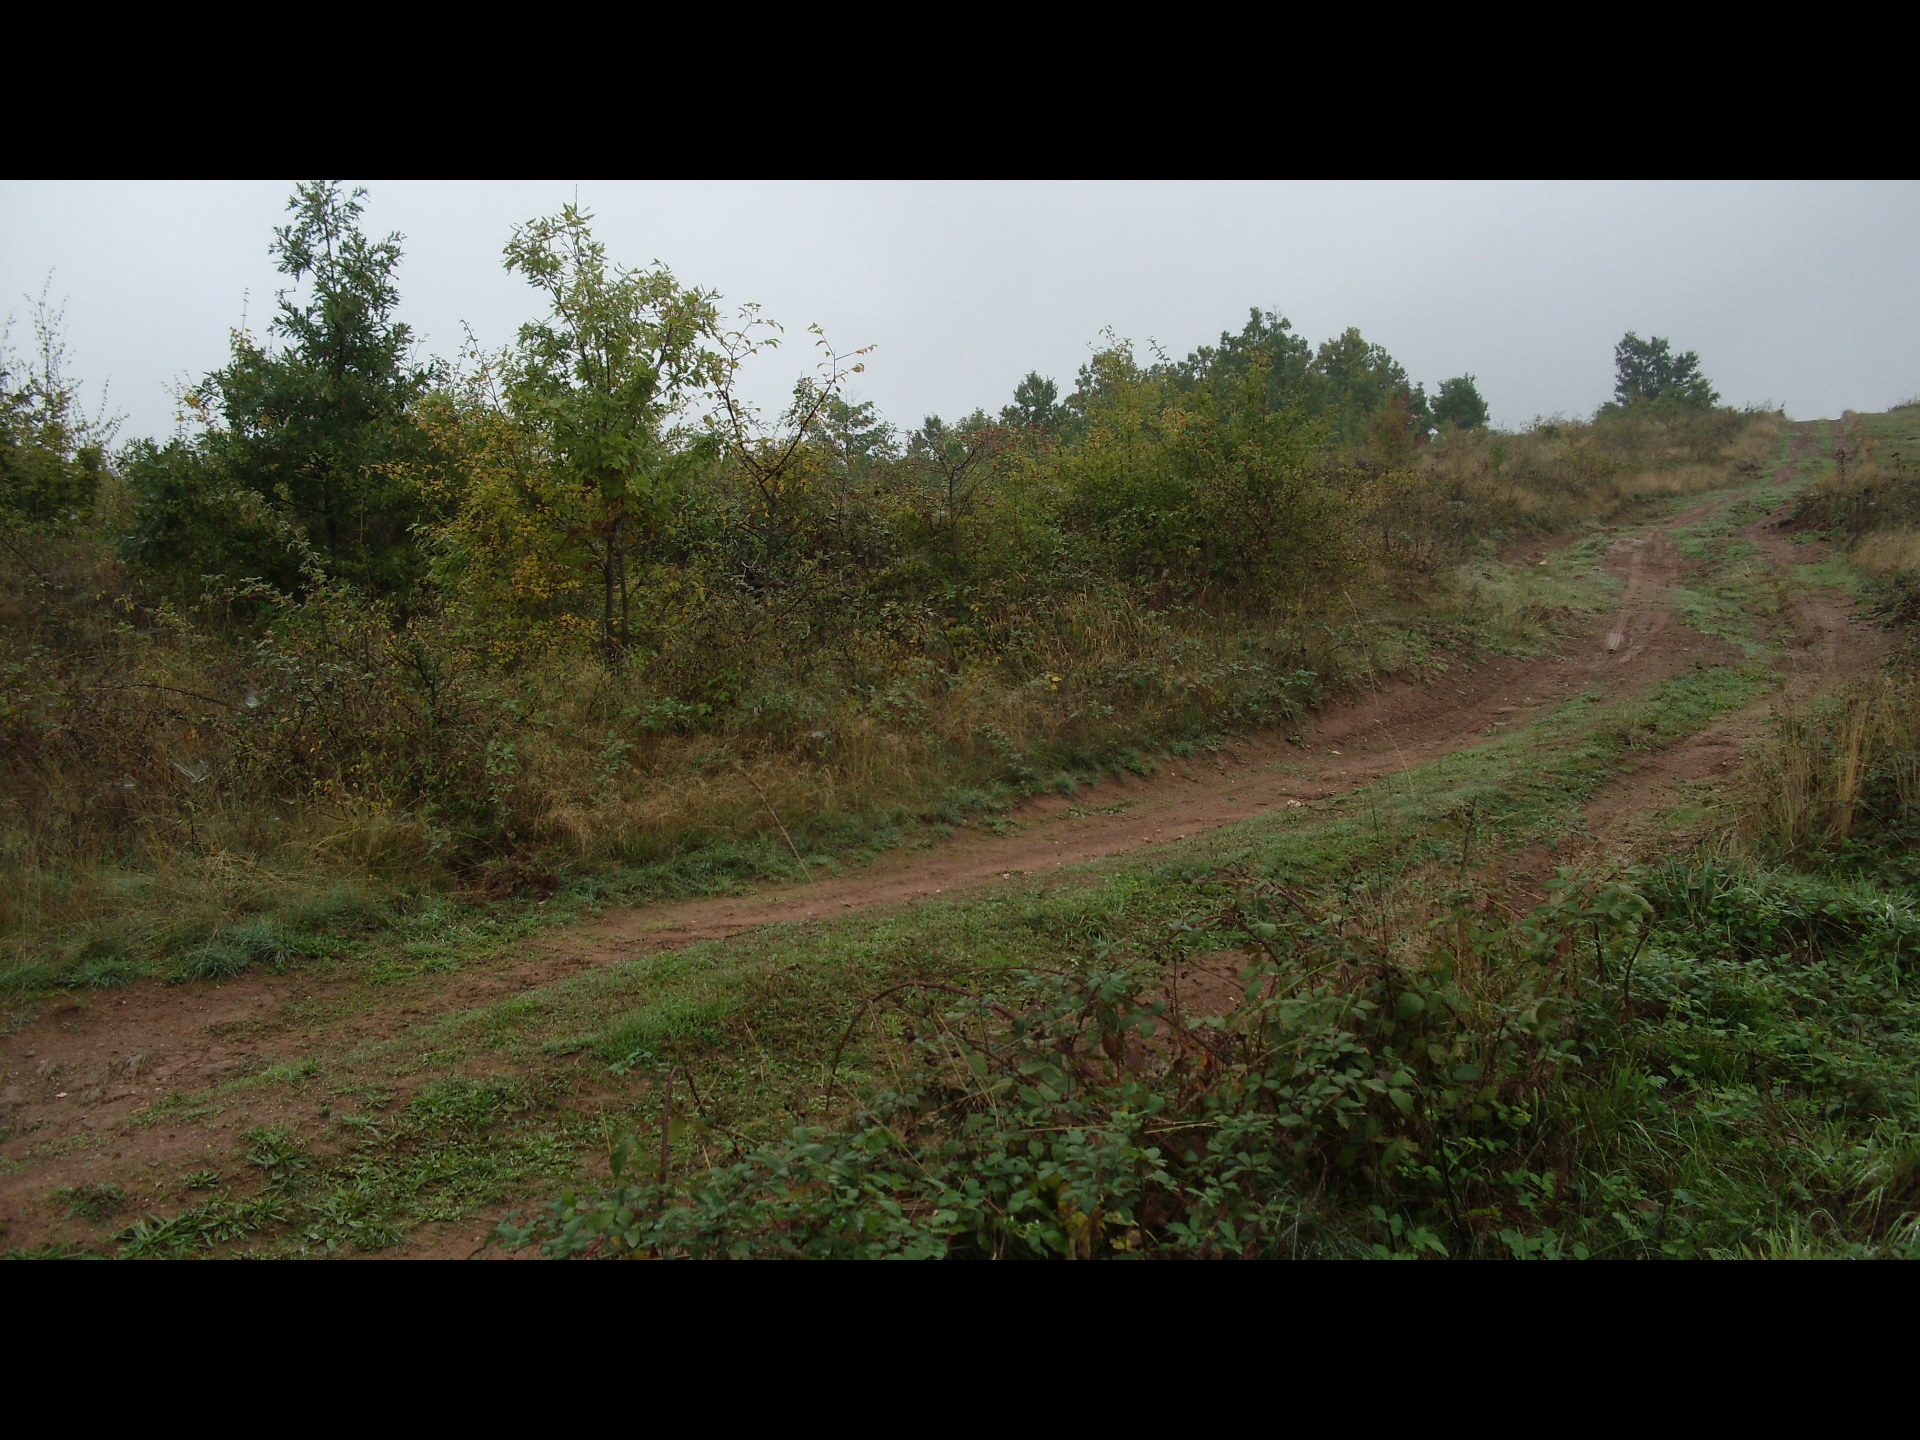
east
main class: Grassland
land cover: Grassland without tree/shrub cover
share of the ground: > 75 %
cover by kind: herbaceous plants 95 %, unconsolidated bare surface 5 %
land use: Agriculture (excluding fallow land and kitchen gardens)
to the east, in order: Grassland without tree/shrub cover; Tracks; Shrubland with sparse tree cover; Broadleaved woodland; Rivers and streams; Broadleaved woodland
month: October
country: BG
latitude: 43.5191
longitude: 22.7893
